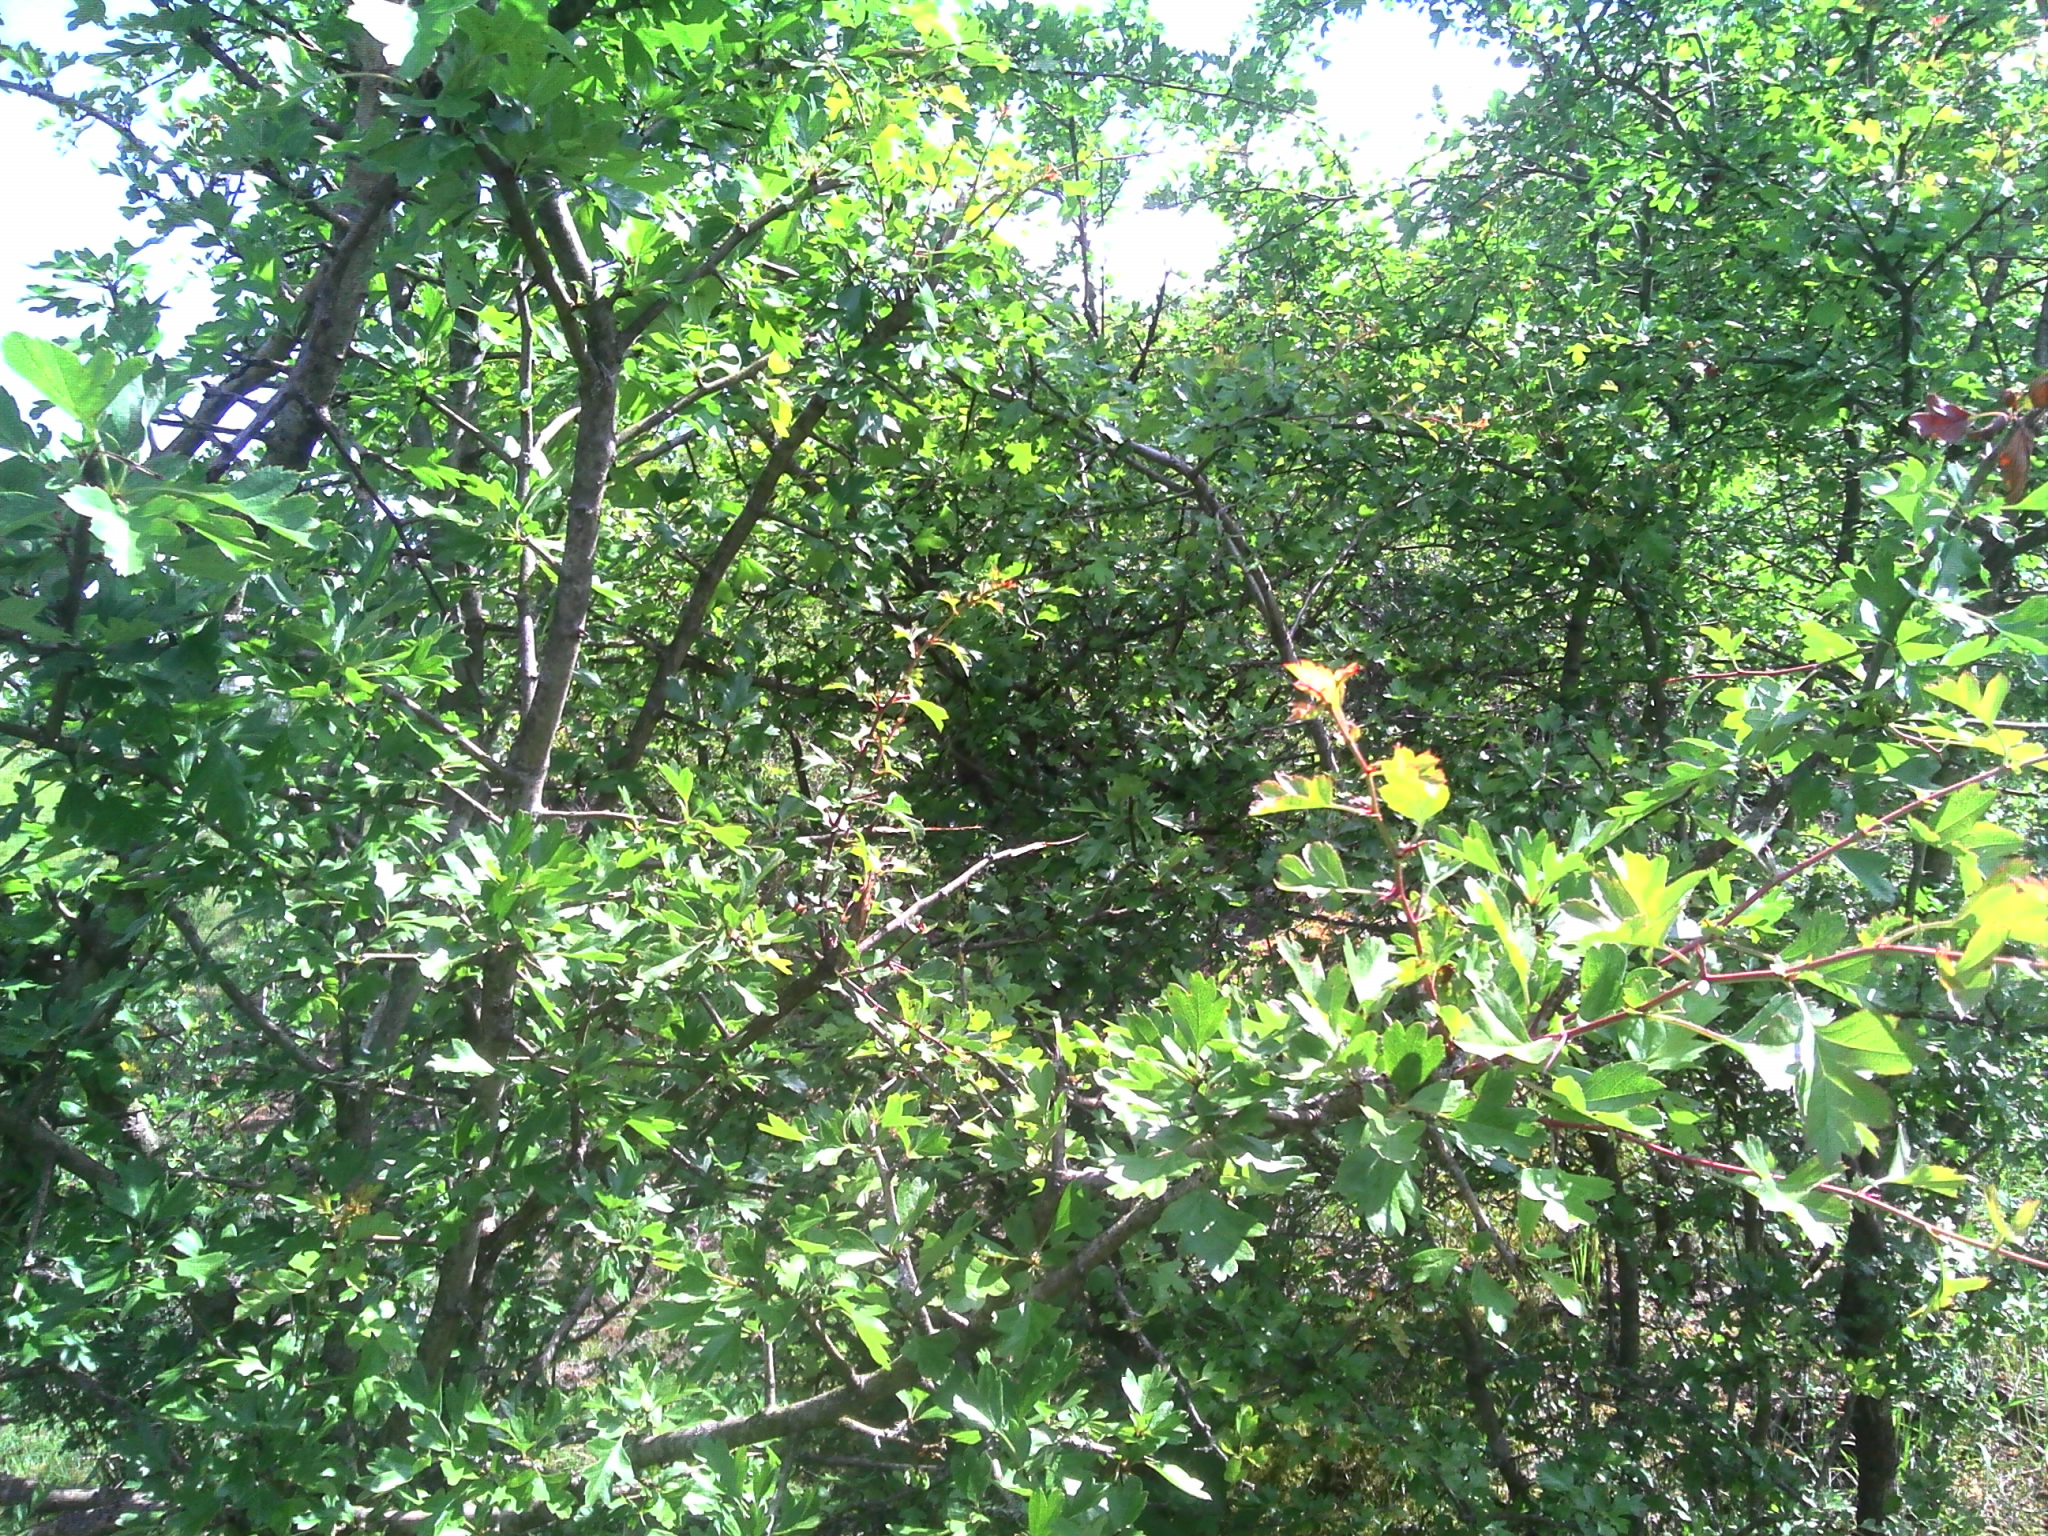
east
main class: Shrubland
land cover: Shrubland without tree cover
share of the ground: > 75 %
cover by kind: shrubs 60 %, herbaceous plants 40 %
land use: Agriculture (excluding fallow land and kitchen gardens)
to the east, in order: Shrubland without tree cover; Fences; Paved roads, cycling and walking lanes; Grassland without tree/shrub cover; Spruce dominated coniferous woodland; Fences; Grassland without tree/shrub cover; Maize
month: June
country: BE
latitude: 50.2865
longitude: 5.3243
